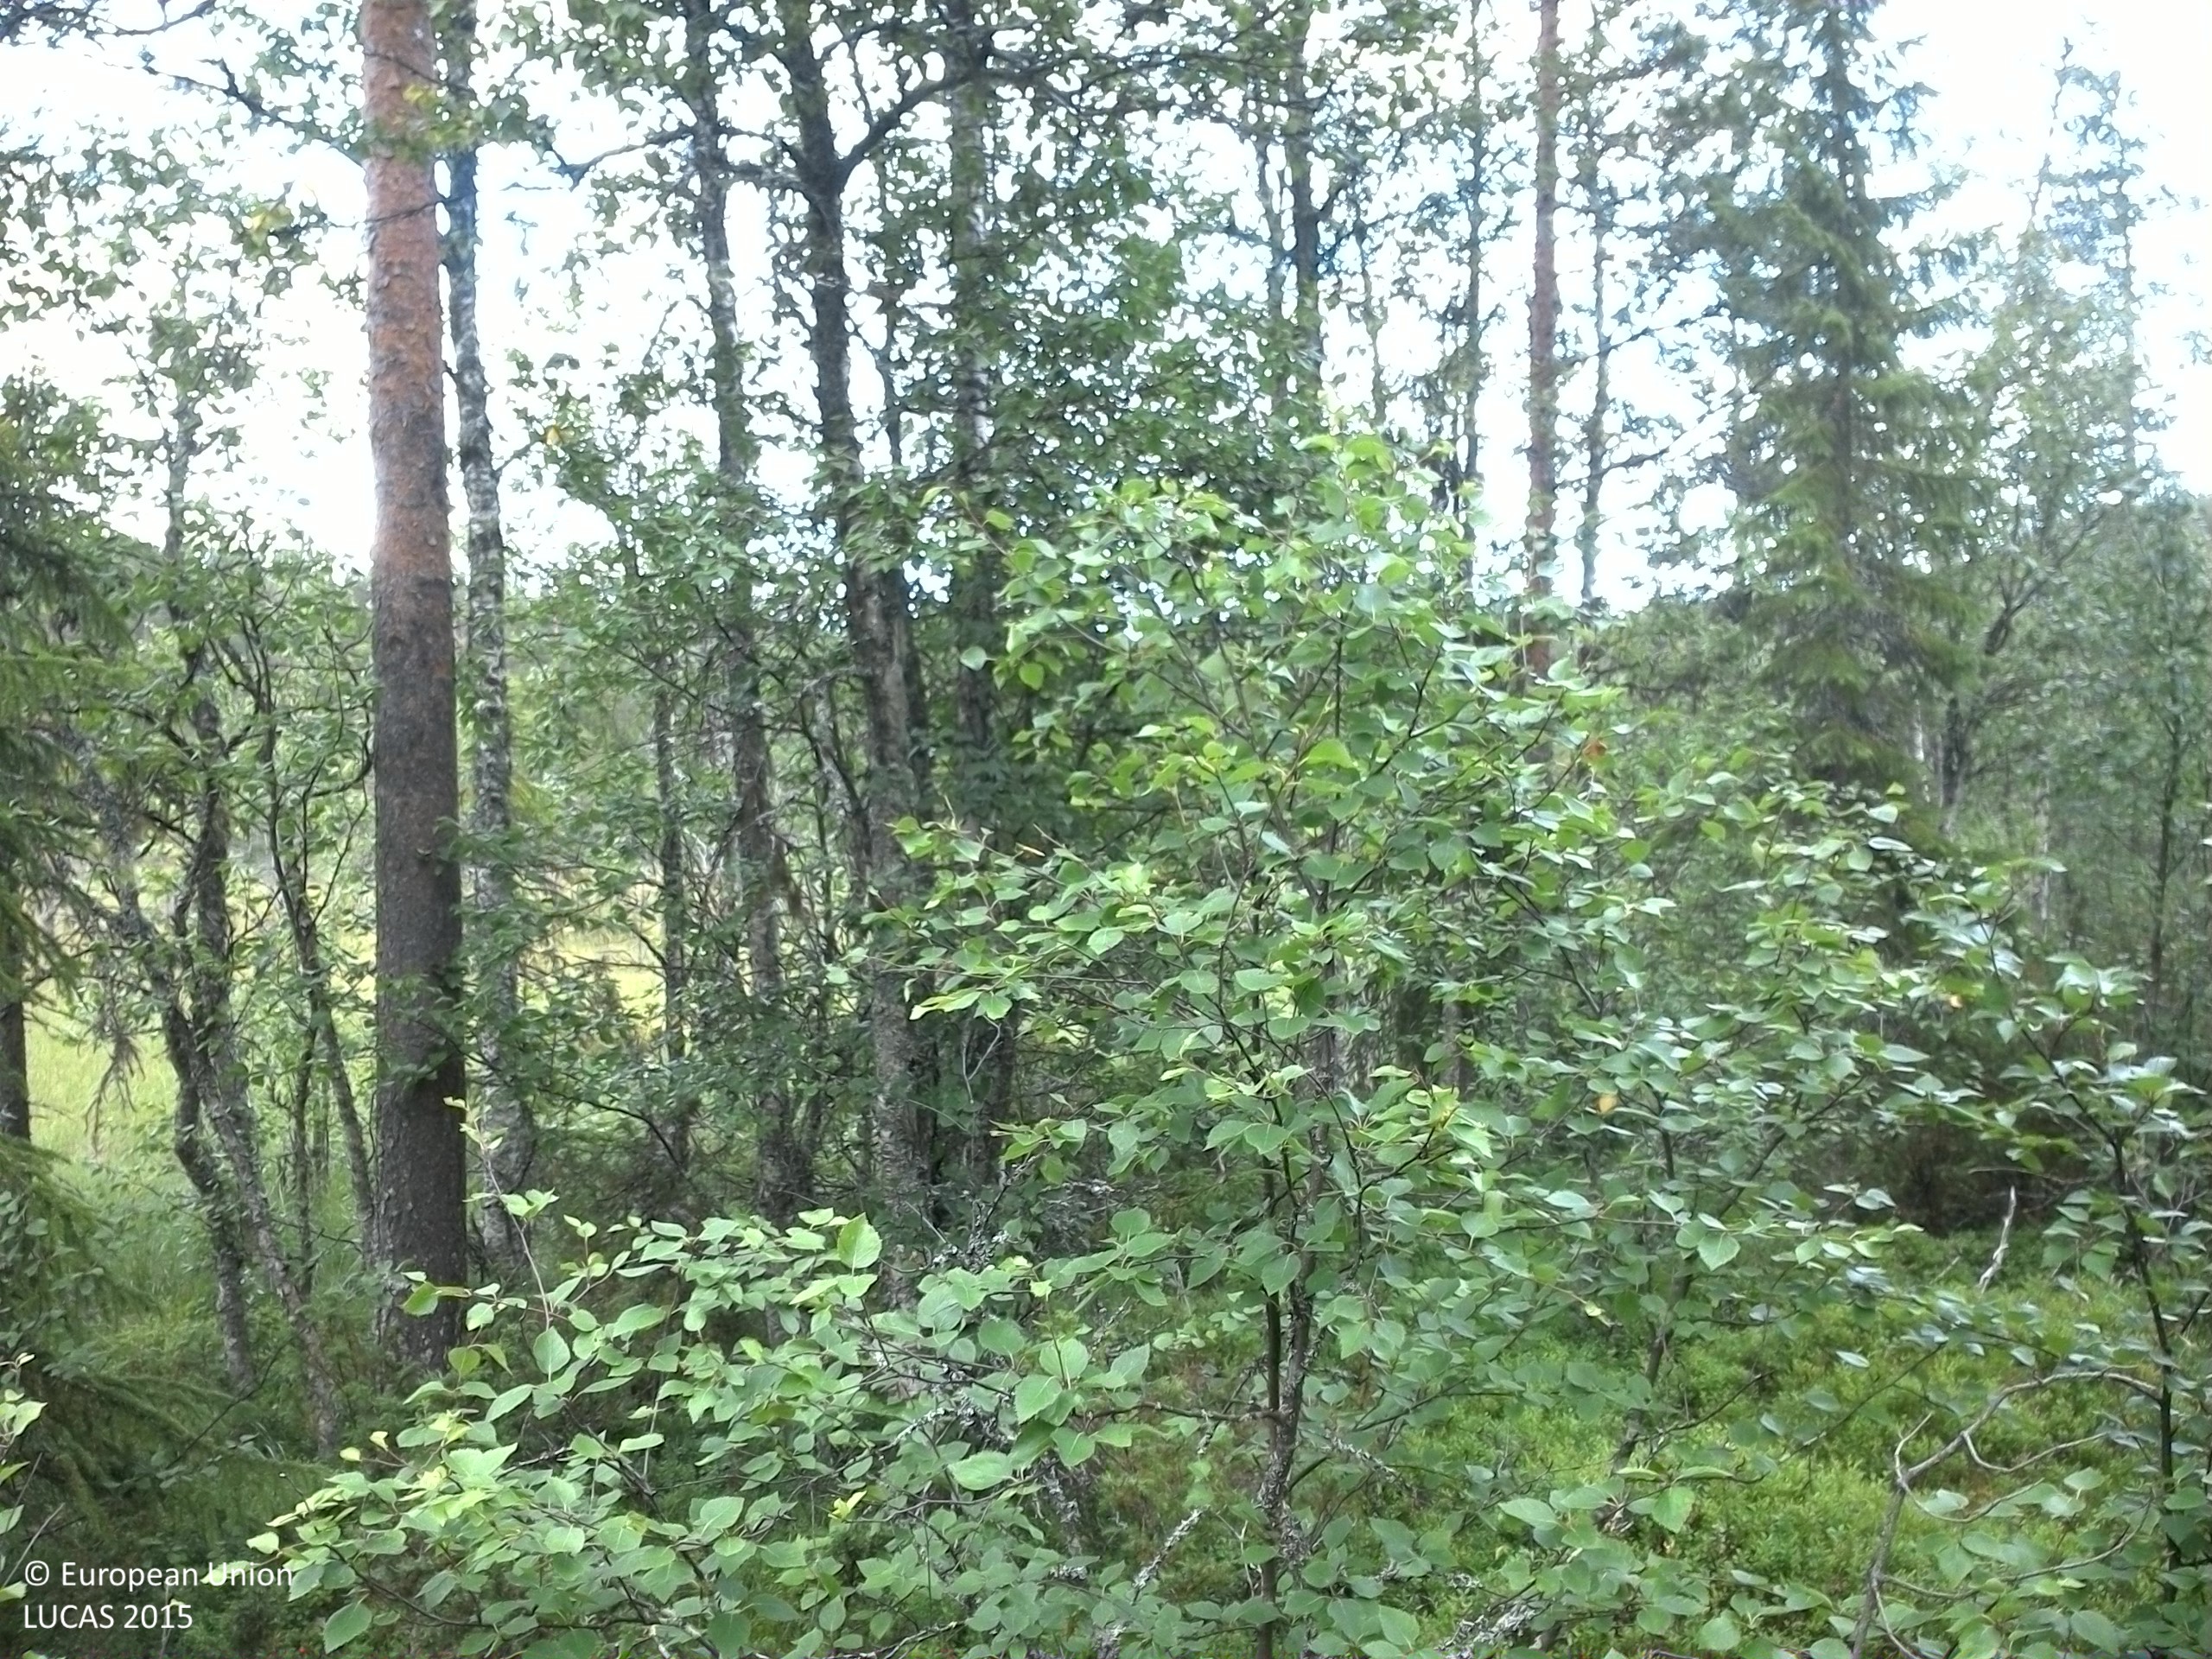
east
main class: Woodland
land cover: Pine dominated mixed woodland
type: boreal forest
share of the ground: 50 - 75 %
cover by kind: coniferous forest trees 45 %, shrubs 30 %, broadleaved forest trees 15 %, herbaceous plants 5 %, lichens and mosses 5 %
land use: Forestry
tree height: < 5 m
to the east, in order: Pine dominated mixed woodland; Spruce dominated mixed woodland; Pine dominated coniferous woodland; Peatbogs; Pine dominated coniferous woodland; Spruce dominated mixed woodland
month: August
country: SE
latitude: 63.8928
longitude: 17.8949
